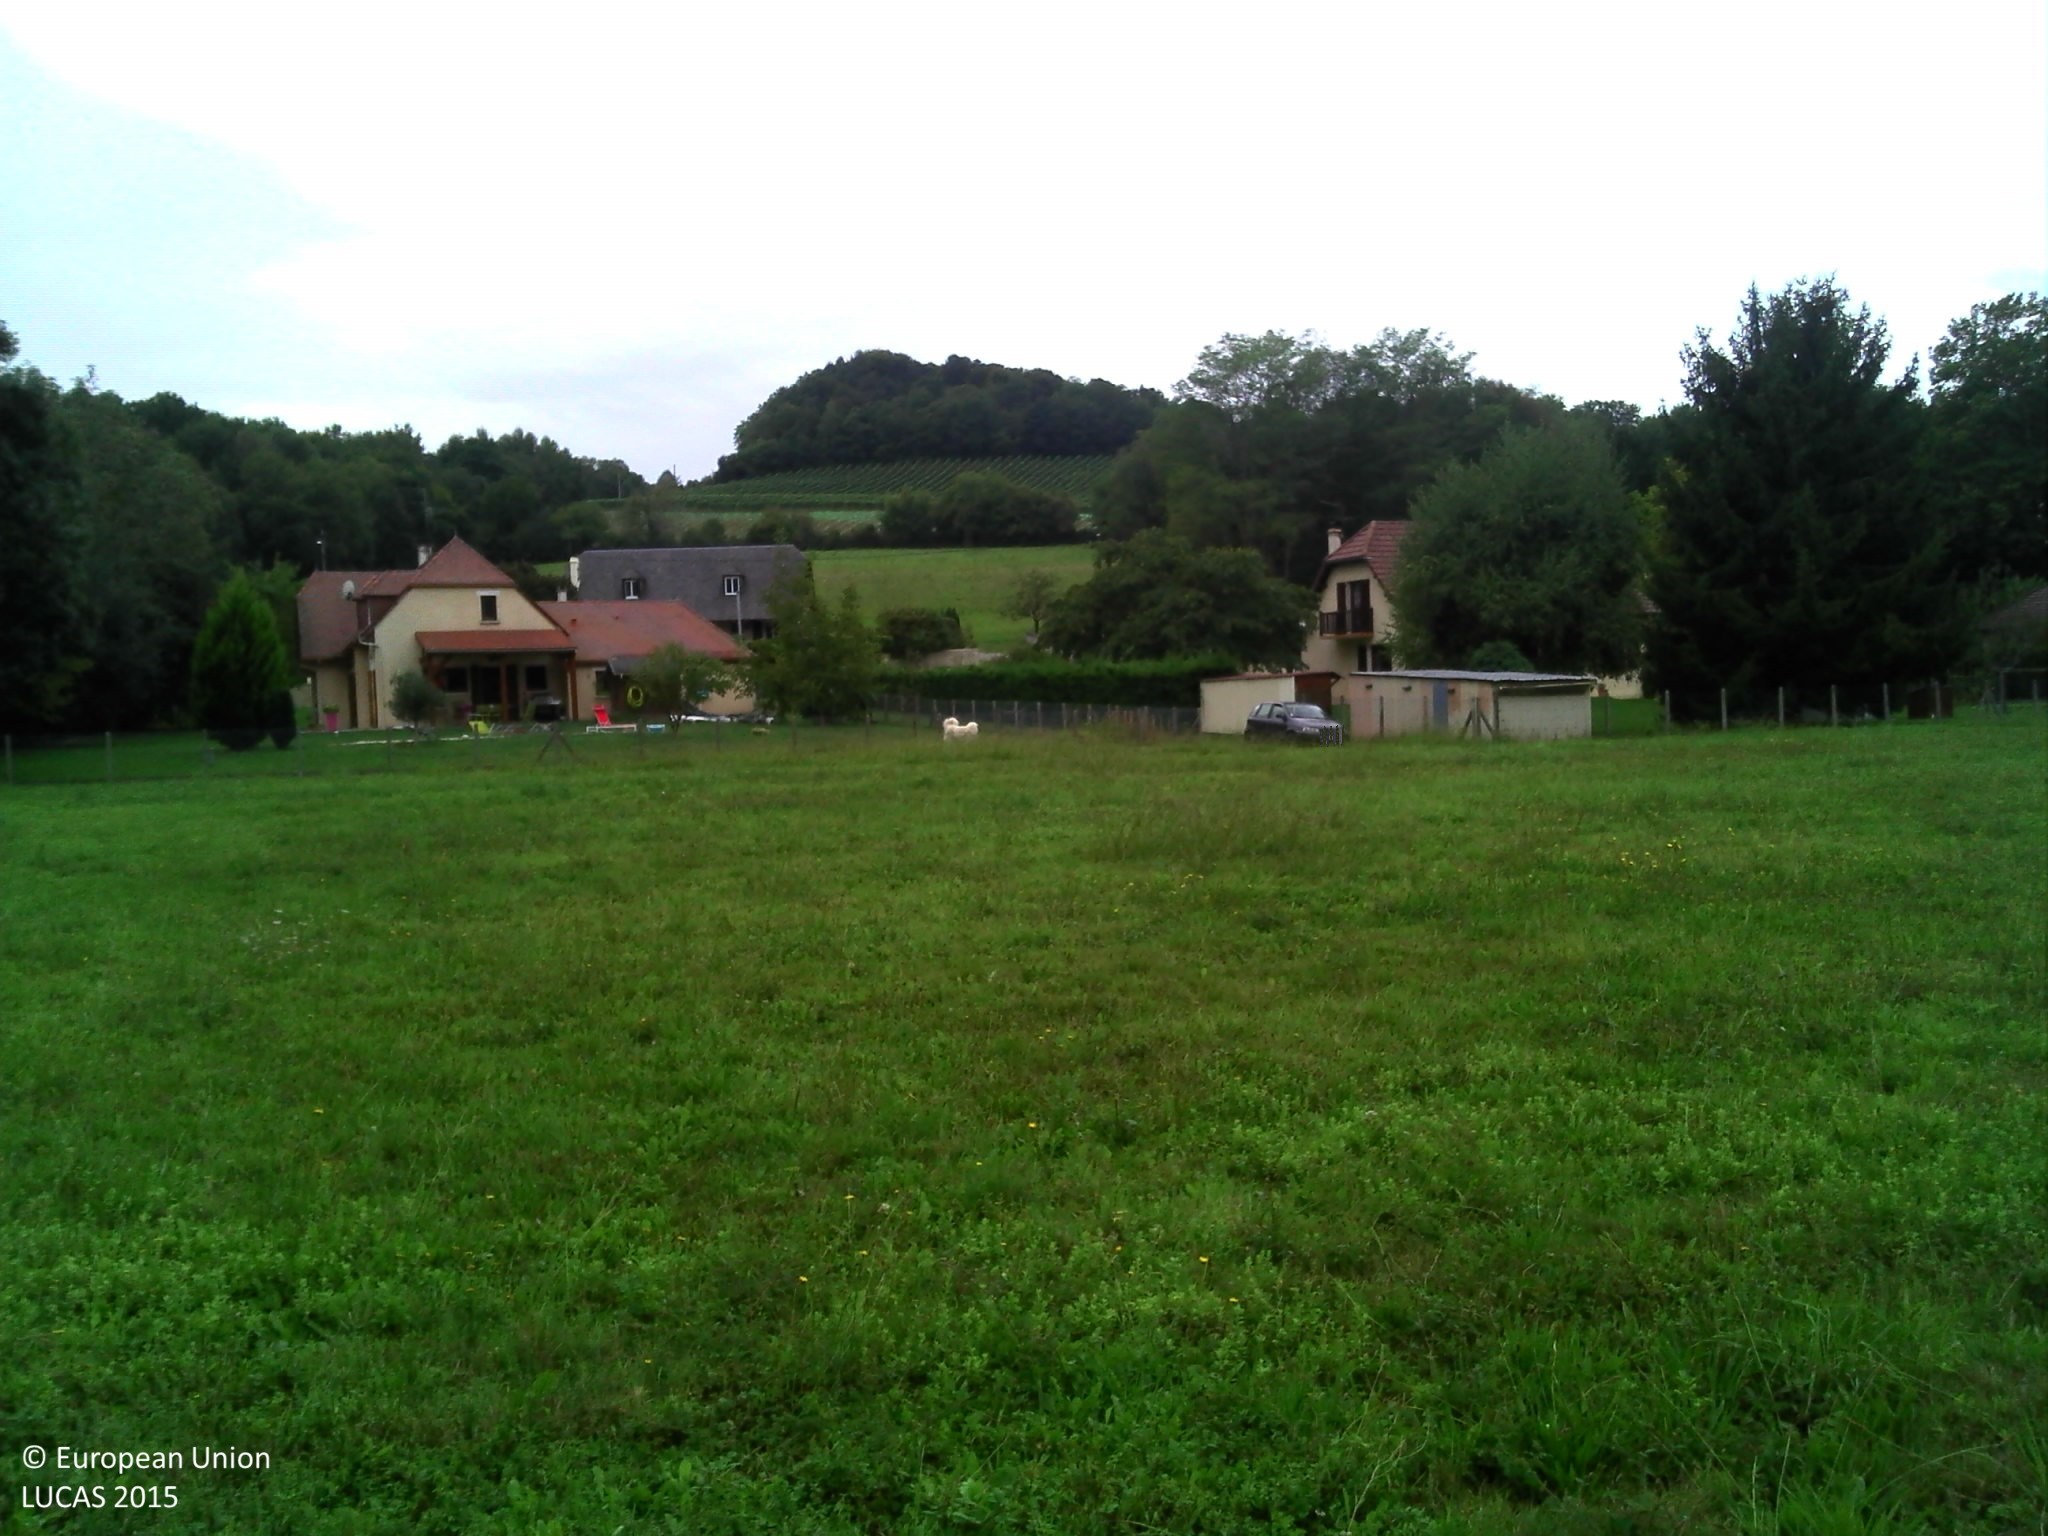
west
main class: Grassland
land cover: Grassland without tree/shrub cover
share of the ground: > 75 %
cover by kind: herbaceous plants 100 %
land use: Agriculture (excluding fallow land and kitchen gardens)
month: September
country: FR
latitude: 43.3100
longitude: -0.4749
